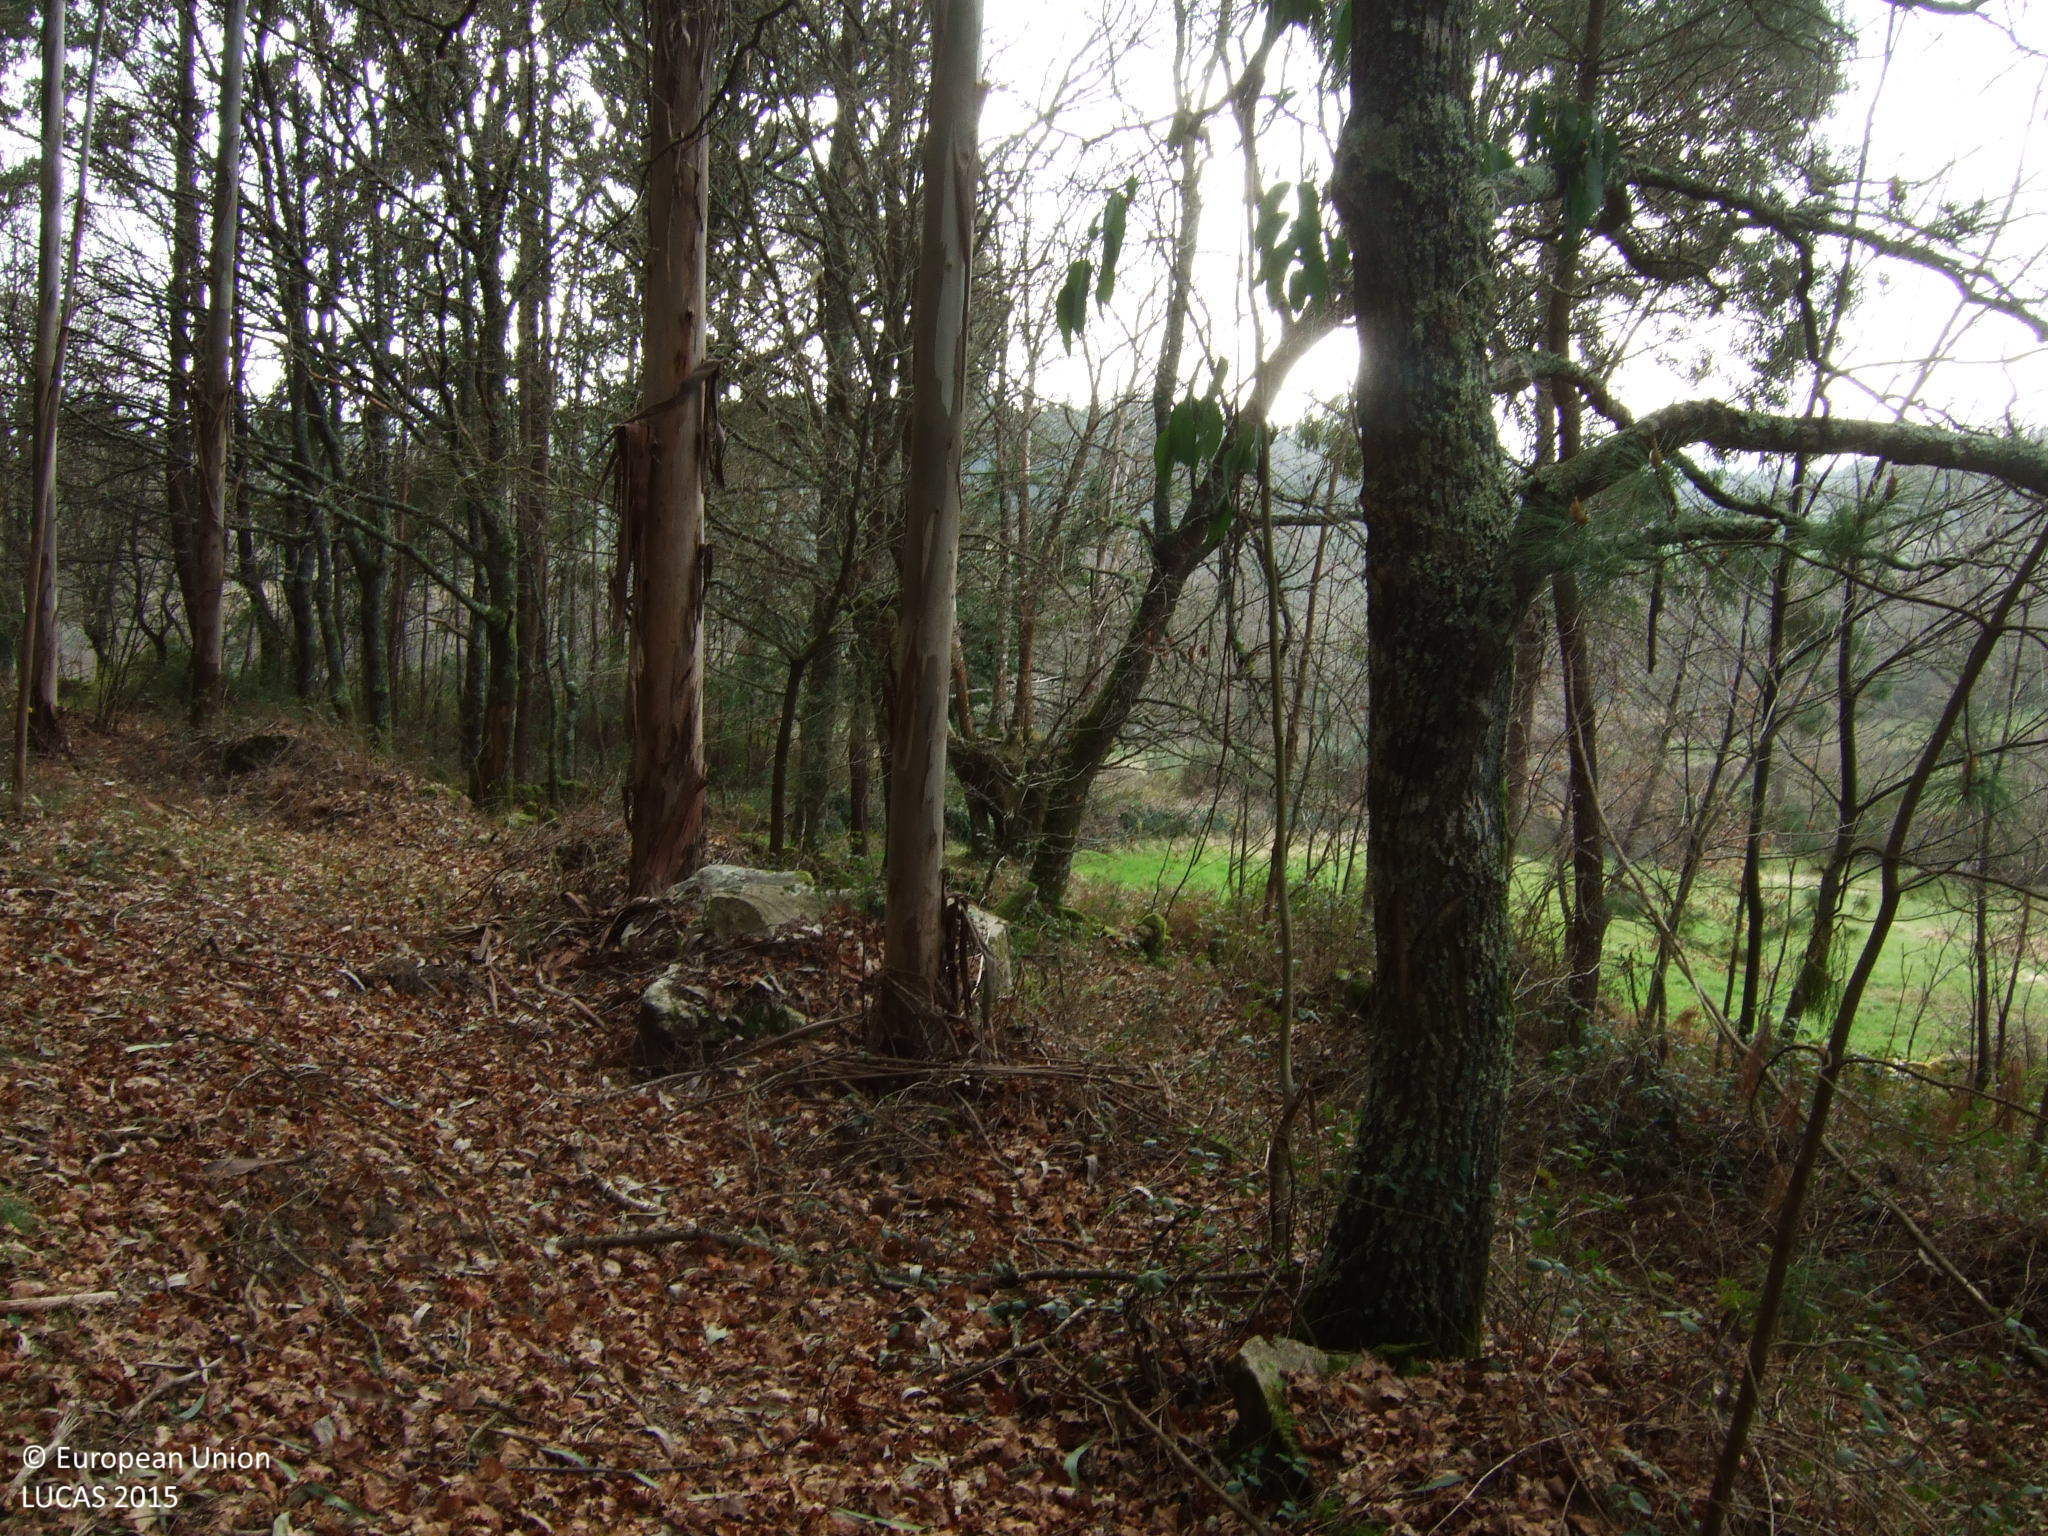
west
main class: Woodland
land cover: Broadleaved woodland
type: exotic forest
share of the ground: > 75 %
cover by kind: broadleaved forest trees 80 %, shrubs 20 %
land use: Forestry
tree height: > 5 m
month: March
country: ES
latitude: 42.8321
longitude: -7.9092
